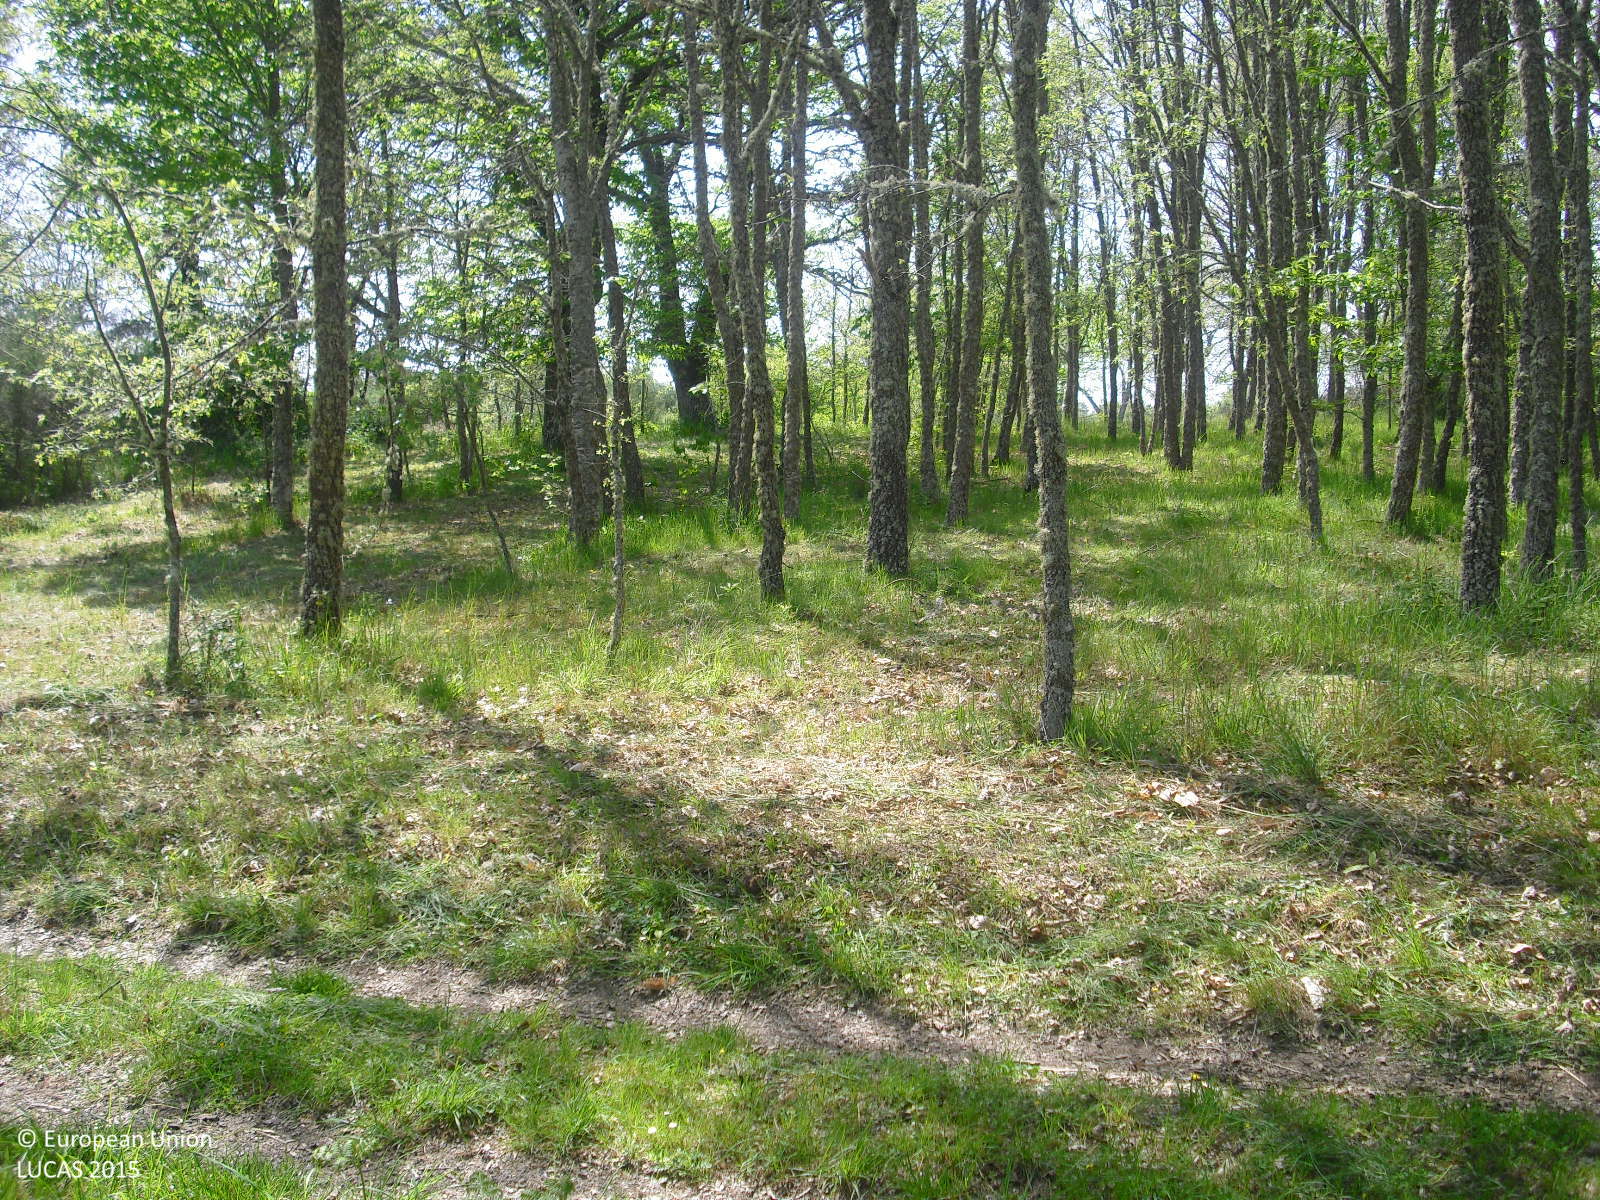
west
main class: Cropland
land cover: Nuts trees
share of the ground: > 75 %
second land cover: Spontaneously vegetated surfaces
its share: > 75 %
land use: Agriculture (excluding fallow land and kitchen gardens)
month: May
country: ES
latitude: 41.9022
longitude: -7.3305
